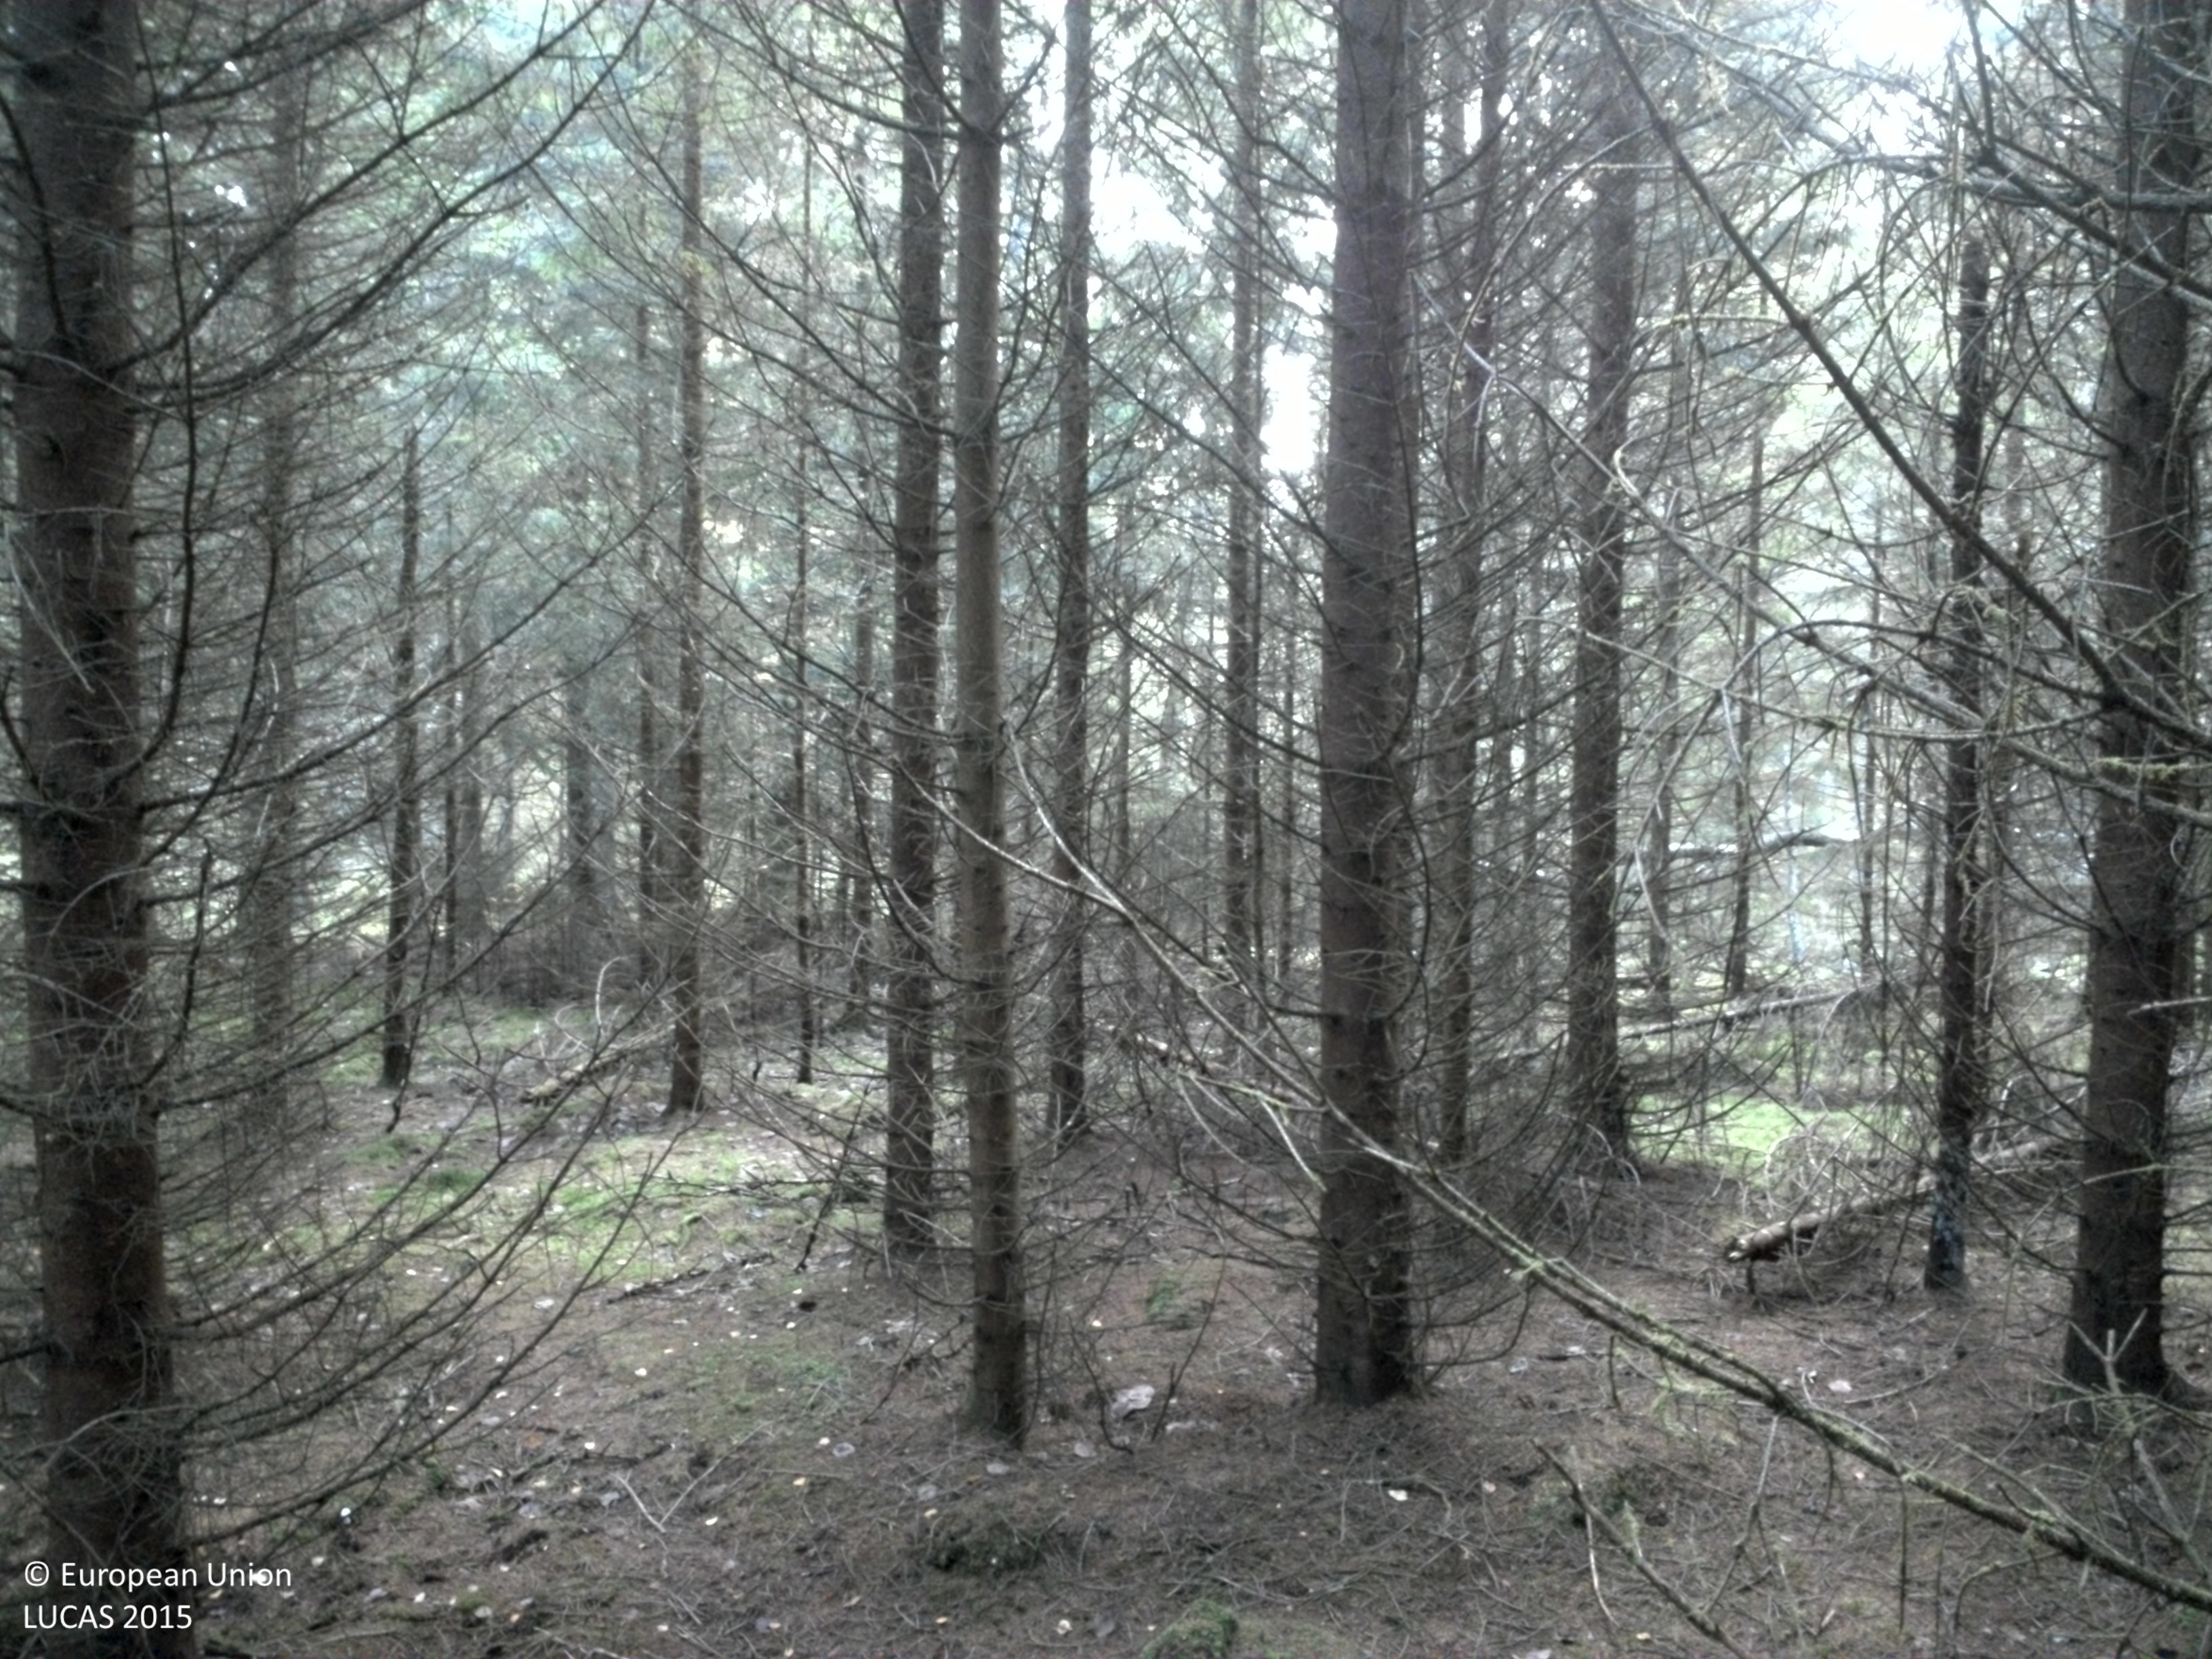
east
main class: Woodland
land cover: Spruce dominated coniferous woodland
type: boreal forest
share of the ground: > 75 %
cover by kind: coniferous forest trees 95 %, lichens and mosses 5 %
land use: Forestry
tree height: > 5 m
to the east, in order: Spruce dominated coniferous woodland; Spruce dominated mixed woodland; Spruce dominated coniferous woodland; Dry stone walls; Grassland with sparse tree/shrub cover; Spruce dominated coniferous woodland; Rivers and streams; Spruce dominated mixed woodland
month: September
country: SE
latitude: 57.9102
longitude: 13.2523
